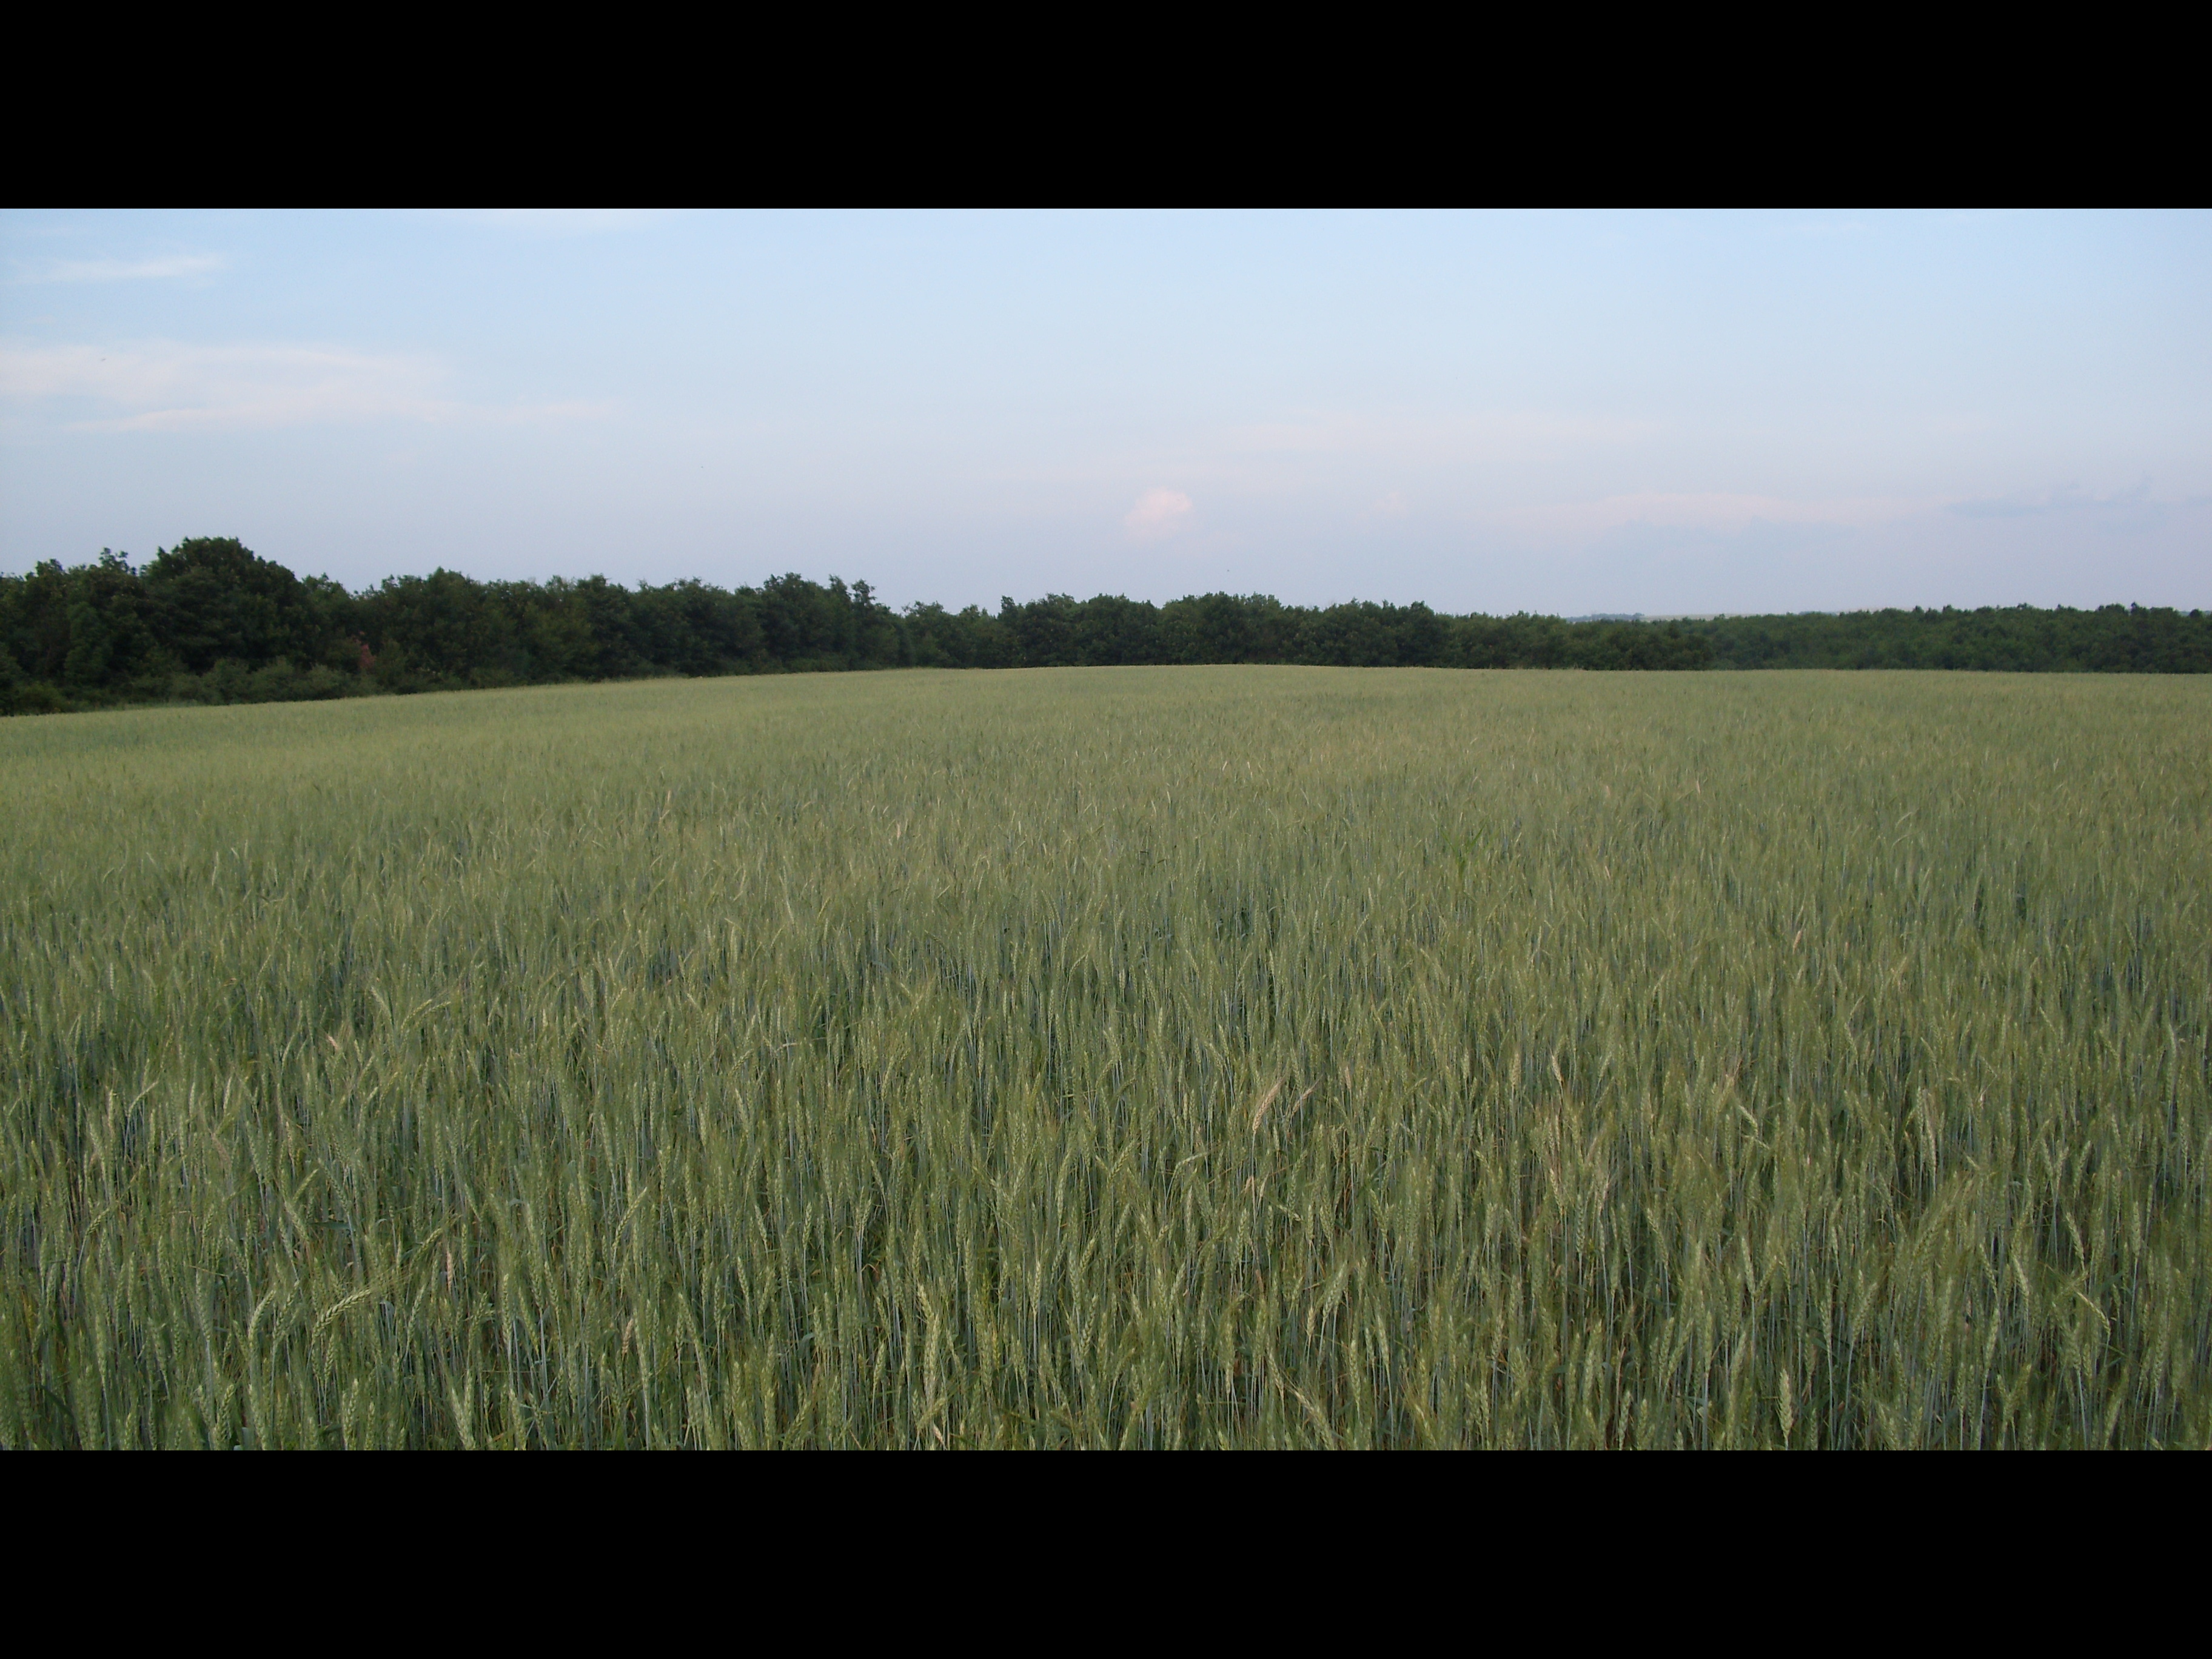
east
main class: Cropland
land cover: Common wheat
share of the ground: > 75 %
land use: Agriculture (excluding fallow land and kitchen gardens)
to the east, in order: Common wheat; Grass margins; Broadleaved woodland
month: June
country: BG
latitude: 43.5066
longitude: 23.3136
